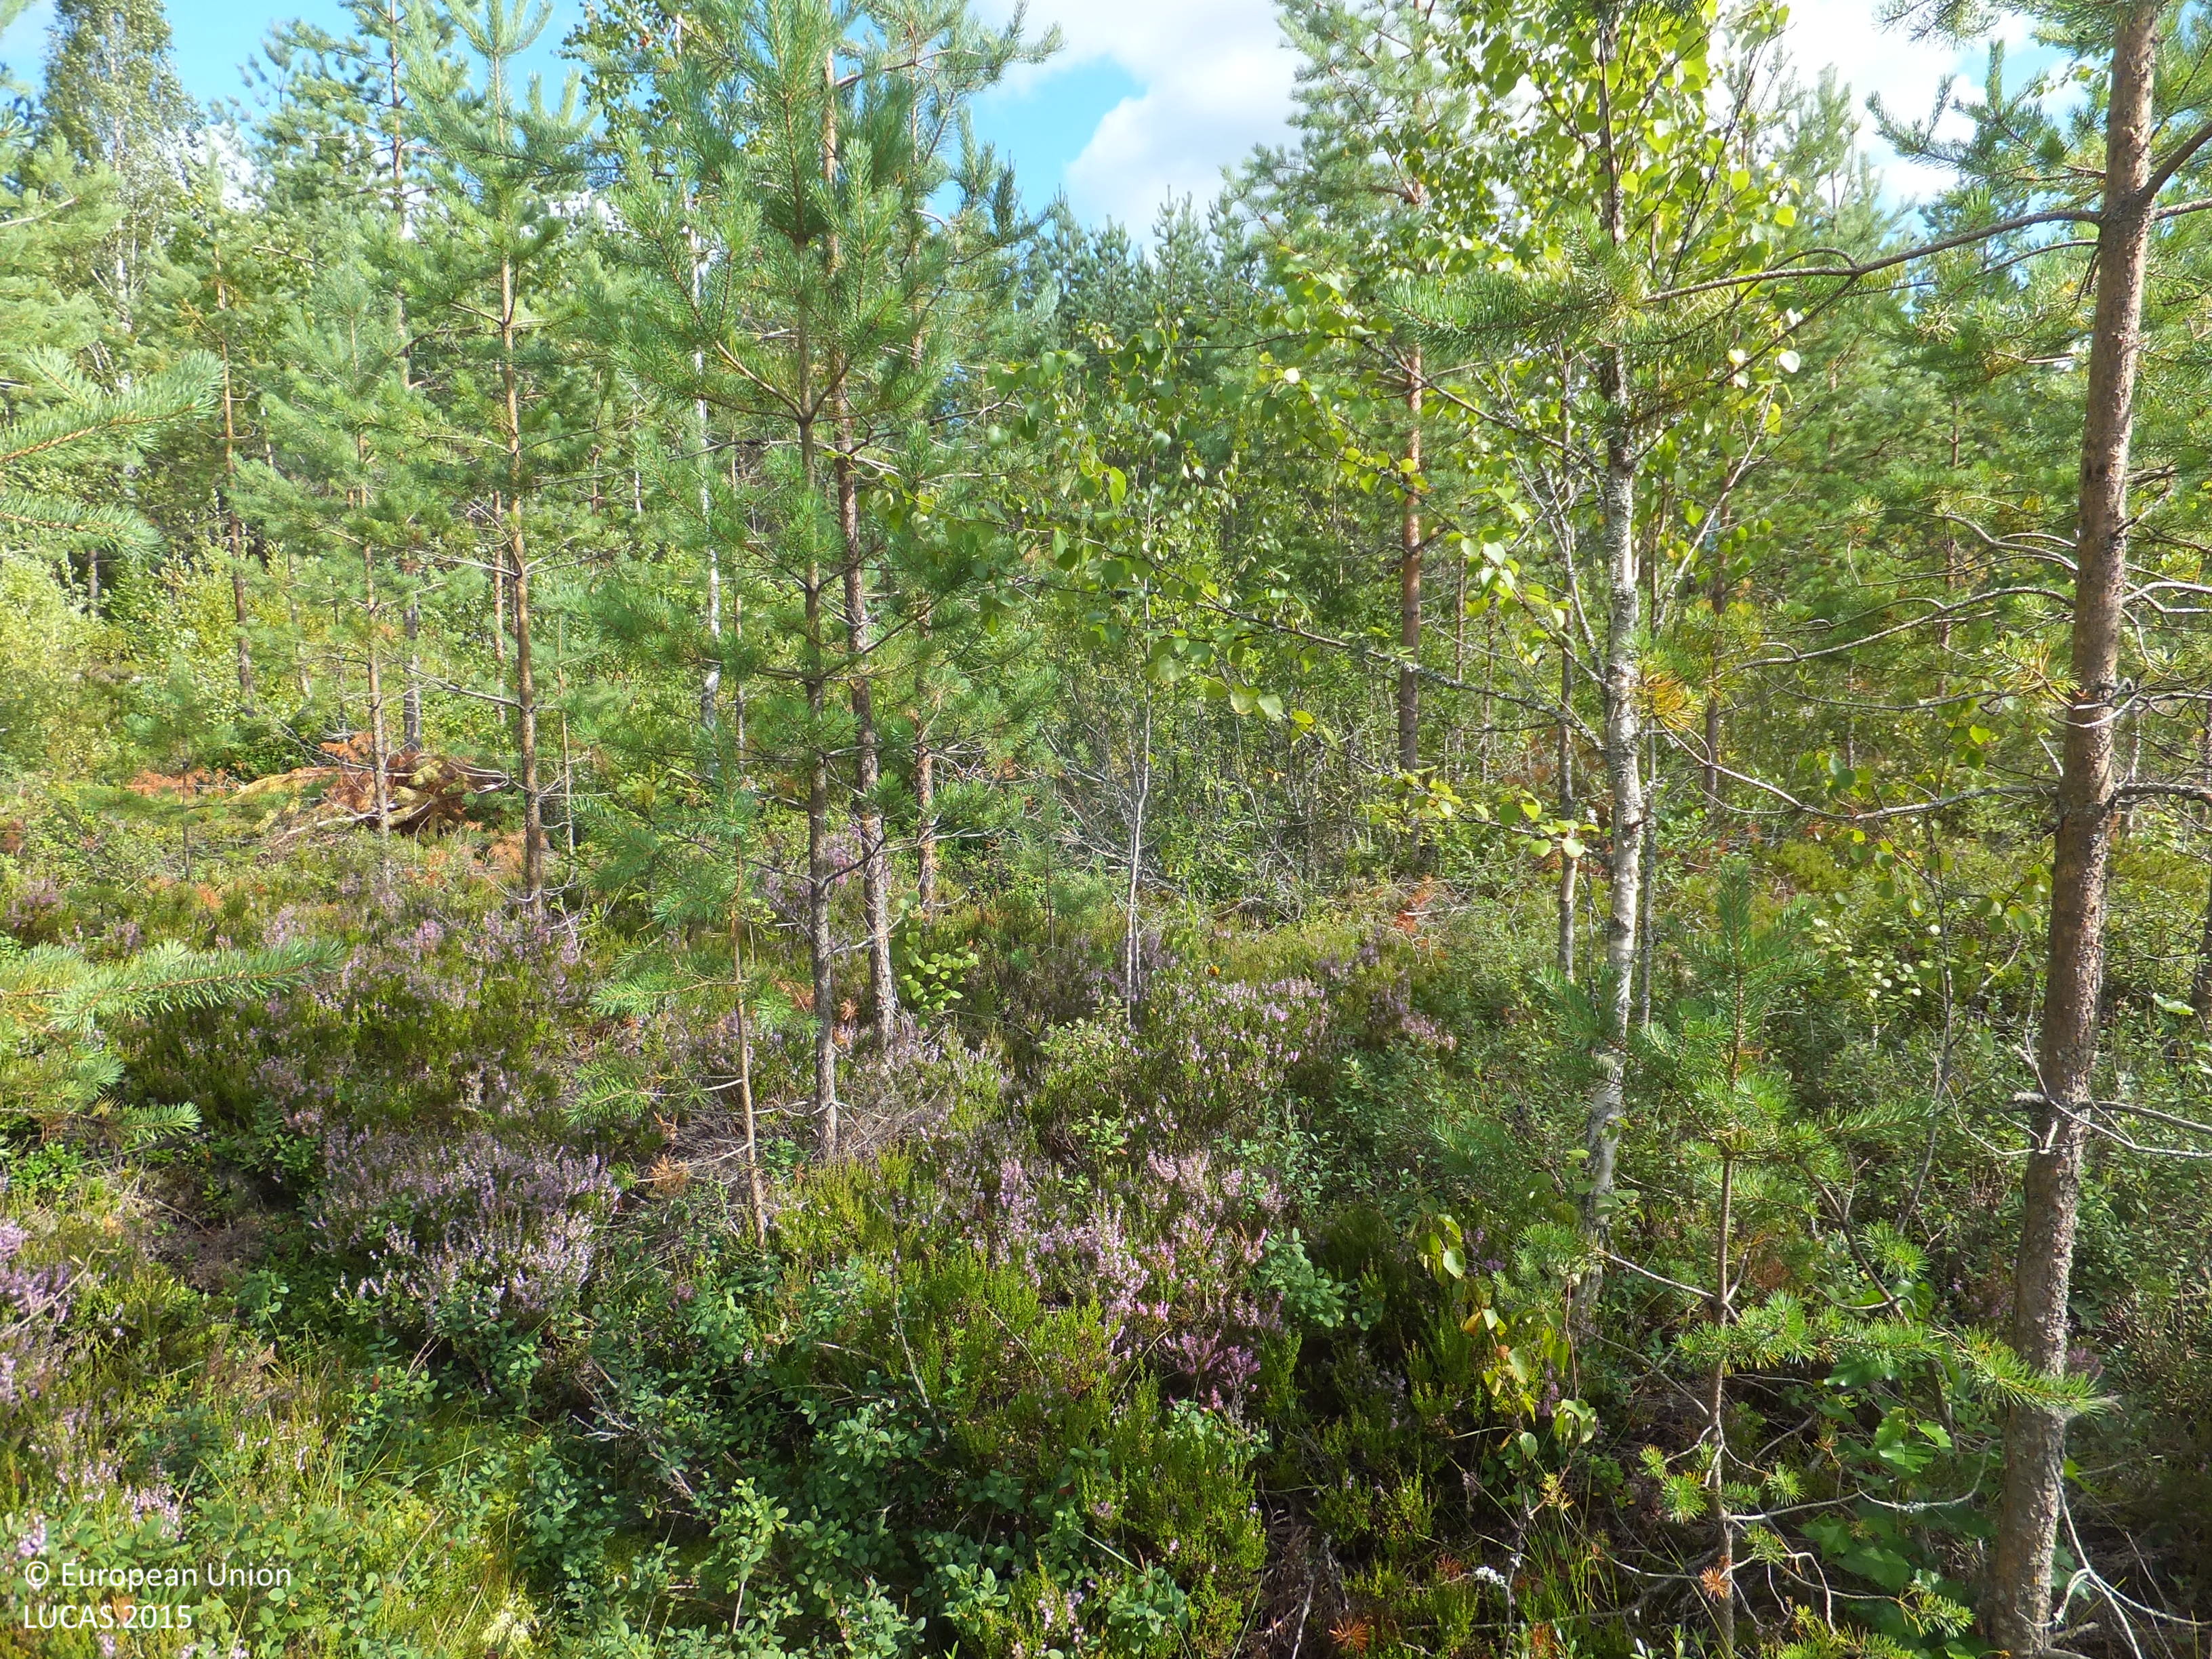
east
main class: Woodland
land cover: Pine dominated mixed woodland
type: boreal forest
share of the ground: 25 - 50 %
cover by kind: shrubs 30 %, coniferous forest trees 20 %, broadleaved forest trees 20 %, lichens and mosses 20 %, herbaceous plants 5 %, consolidated bare surface 5 %
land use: Forestry
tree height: < 5 m
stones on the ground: 10 - 25 %
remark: Nursery
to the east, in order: Pine dominated mixed woodland; Ditches and canals; Abandoned hedges; Paved roads, cycling and walking lanes; Ditches and canals; Pine dominated coniferous woodland; Pine dominated mixed woodland
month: August
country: FI
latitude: 63.2634
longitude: 22.9055
